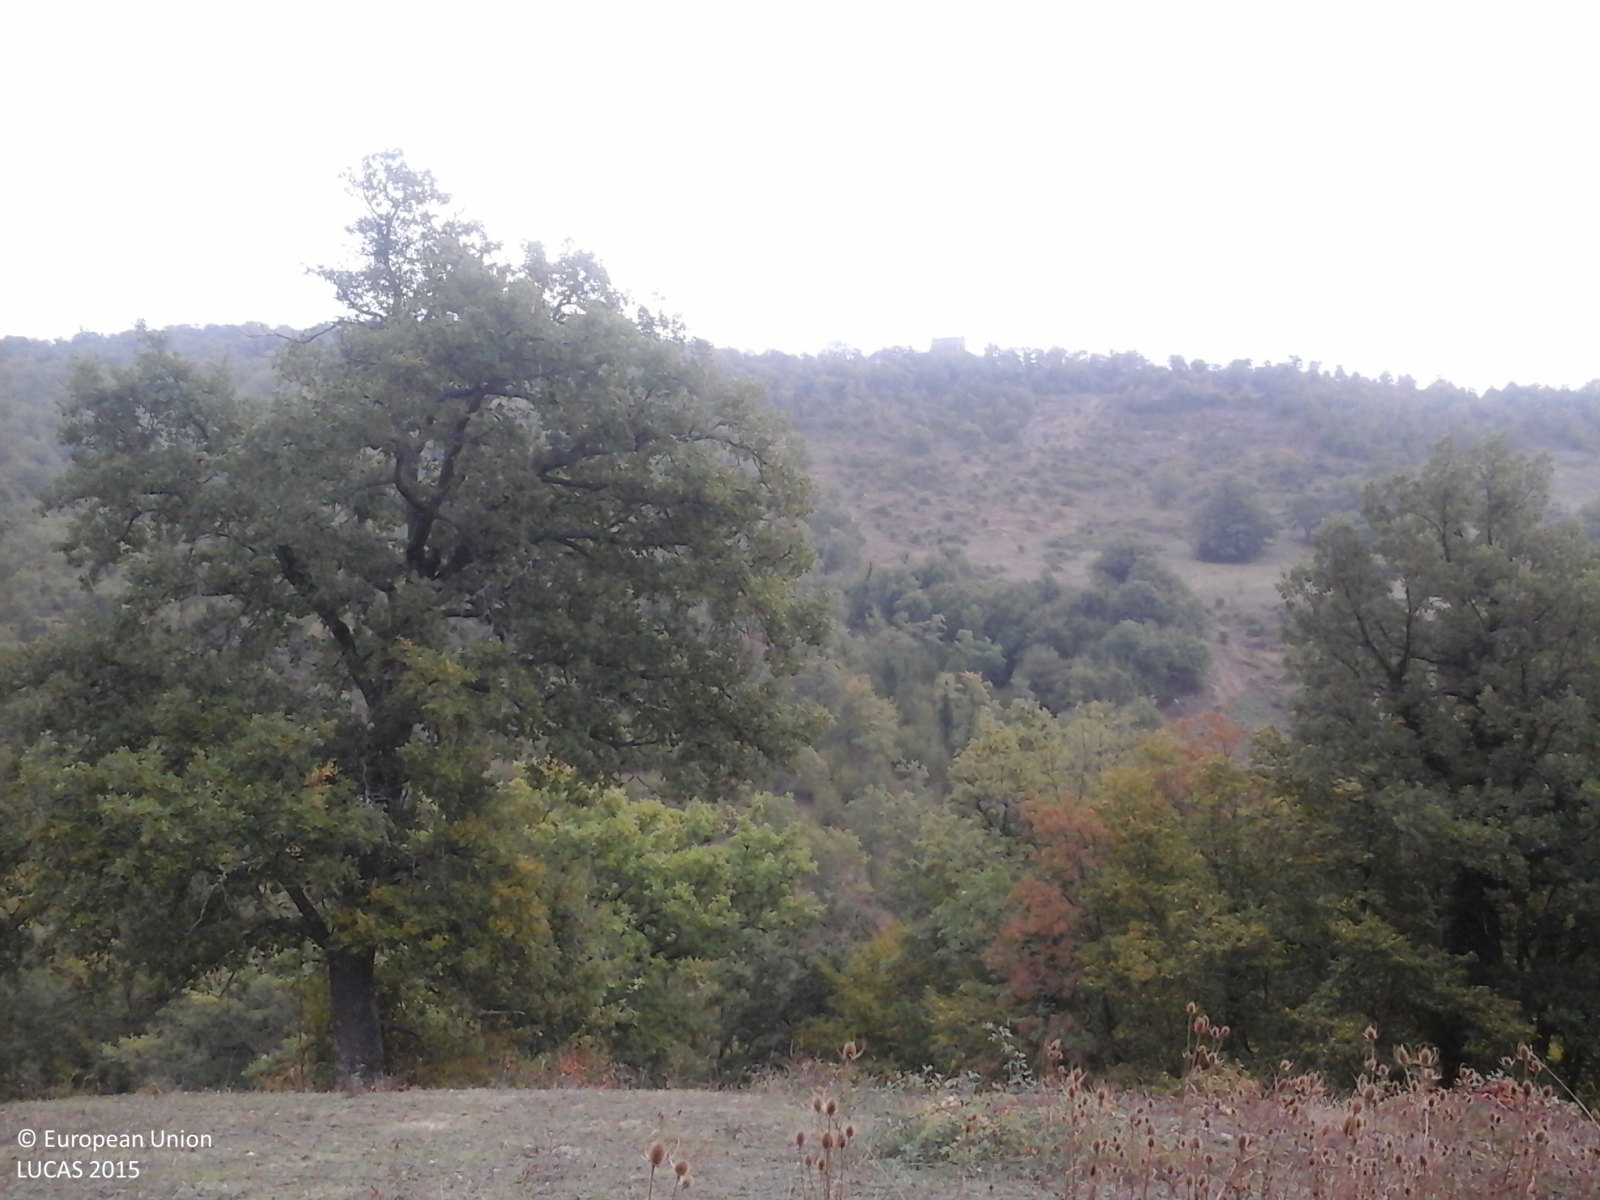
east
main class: Grassland
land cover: Grassland without tree/shrub cover
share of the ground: > 75 %
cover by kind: herbaceous plants 100 %
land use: Agriculture (excluding fallow land and kitchen gardens)
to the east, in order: Grassland without tree/shrub cover; Broadleaved woodland
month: October
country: IT
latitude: 43.3656
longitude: 12.4244
